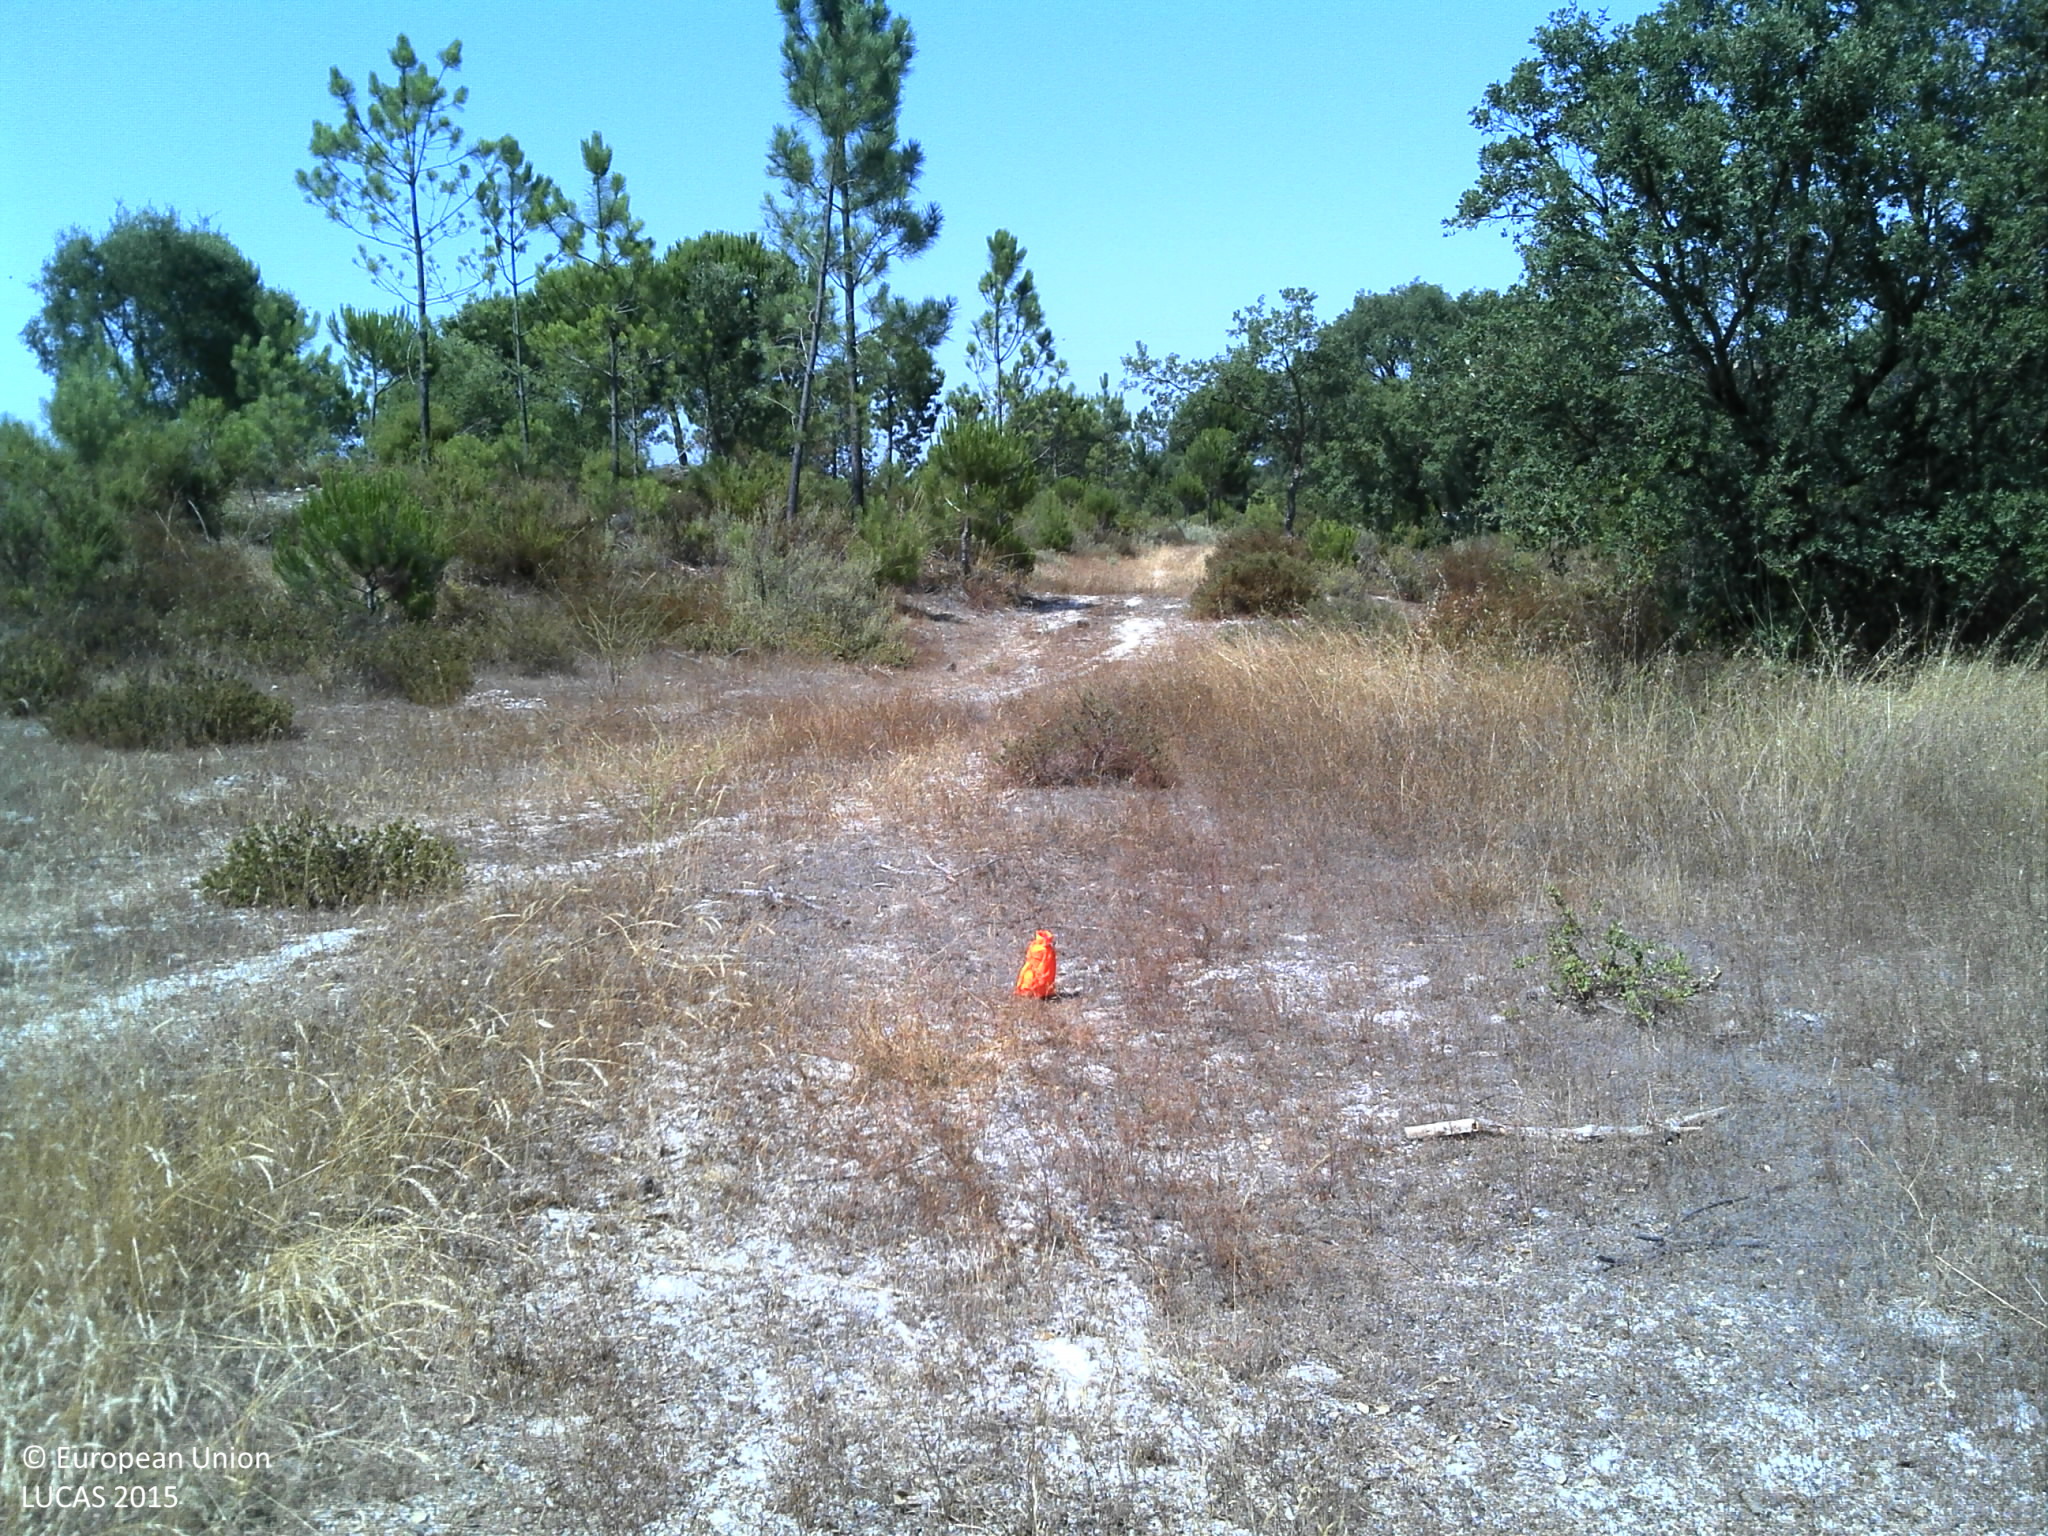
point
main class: Grassland
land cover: Grassland with sparse tree/shrub cover
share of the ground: 25 - 50 %
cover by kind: unconsolidated bare surface 60 %, herbaceous plants 35 %, coniferous forest trees 5 %
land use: Forestry
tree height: > 5 m
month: June
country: PT
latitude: 38.5812
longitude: -9.0685
